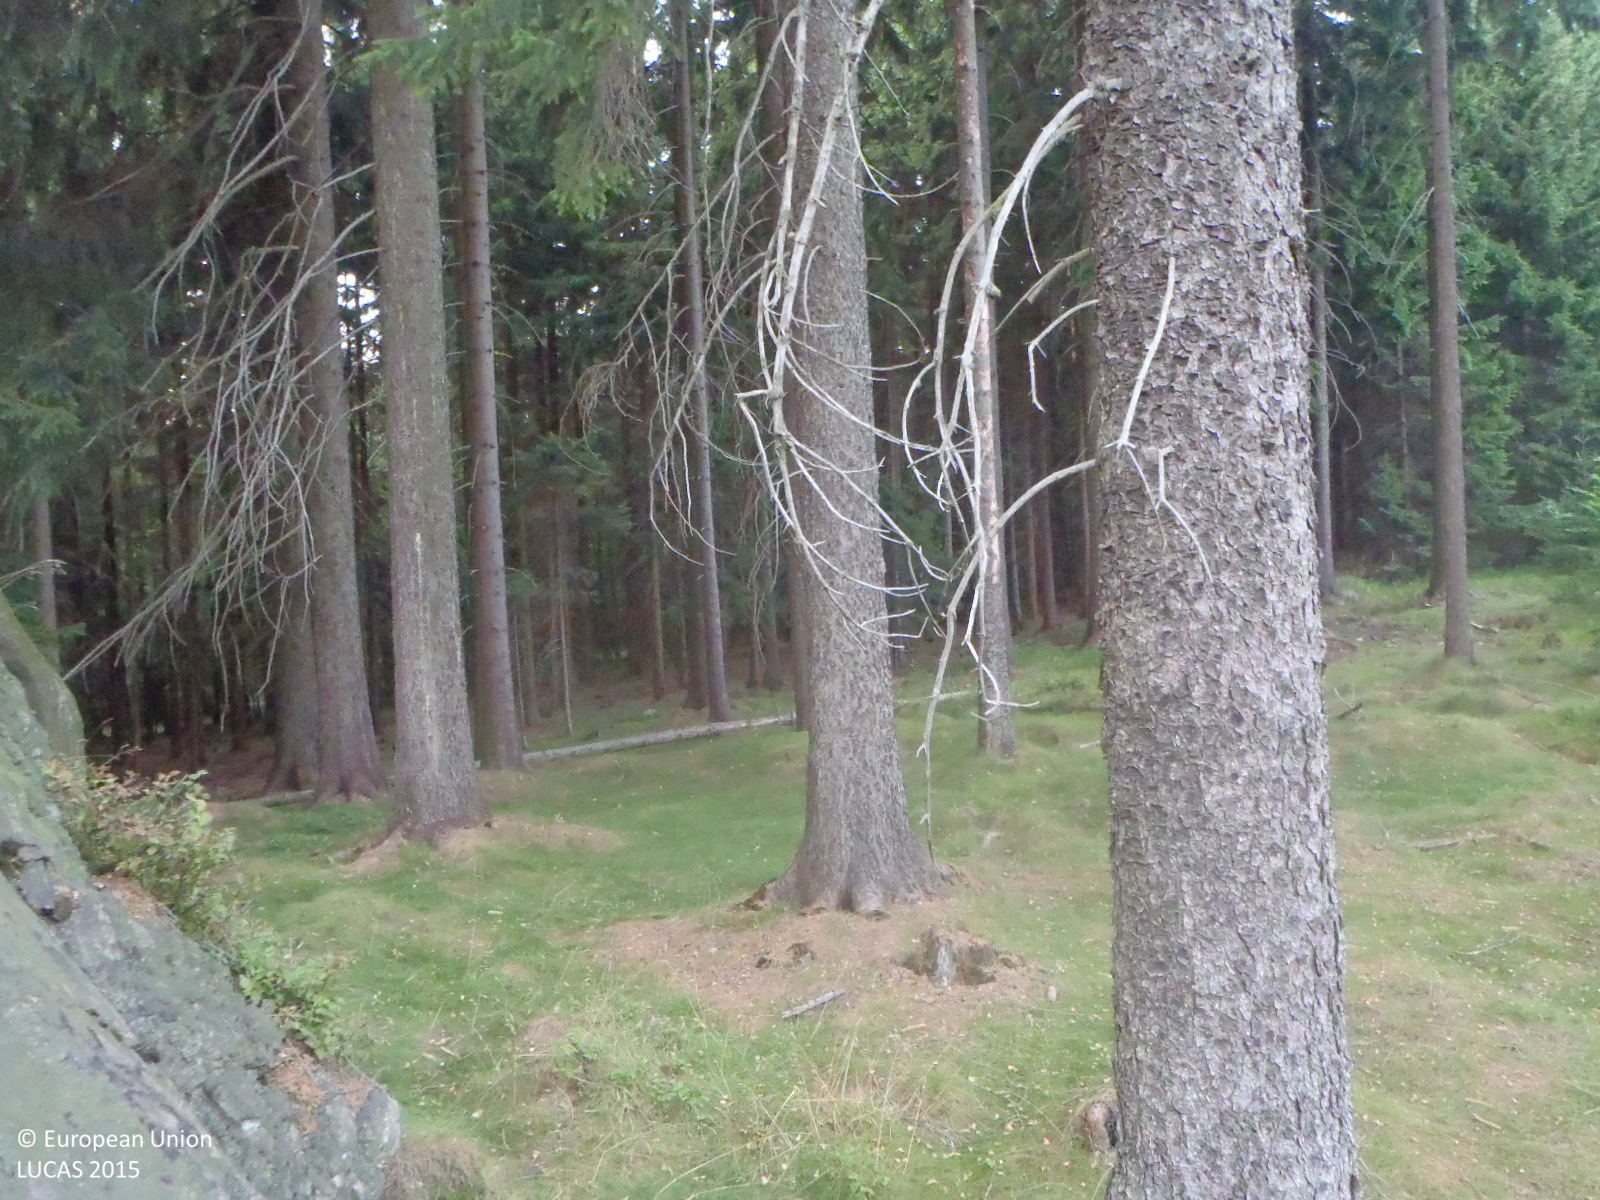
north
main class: Woodland
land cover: Spruce dominated coniferous woodland
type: hemiboreal forest and nemoral coniferous forest and mixed broadleaved-coniferous forest
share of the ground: > 75 %
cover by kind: coniferous forest trees 85 %, broadleaved forest trees 5 %, herbaceous plants 5 %
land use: Forestry
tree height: > 5 m
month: August
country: CZ
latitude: 50.7242
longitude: 14.9750
